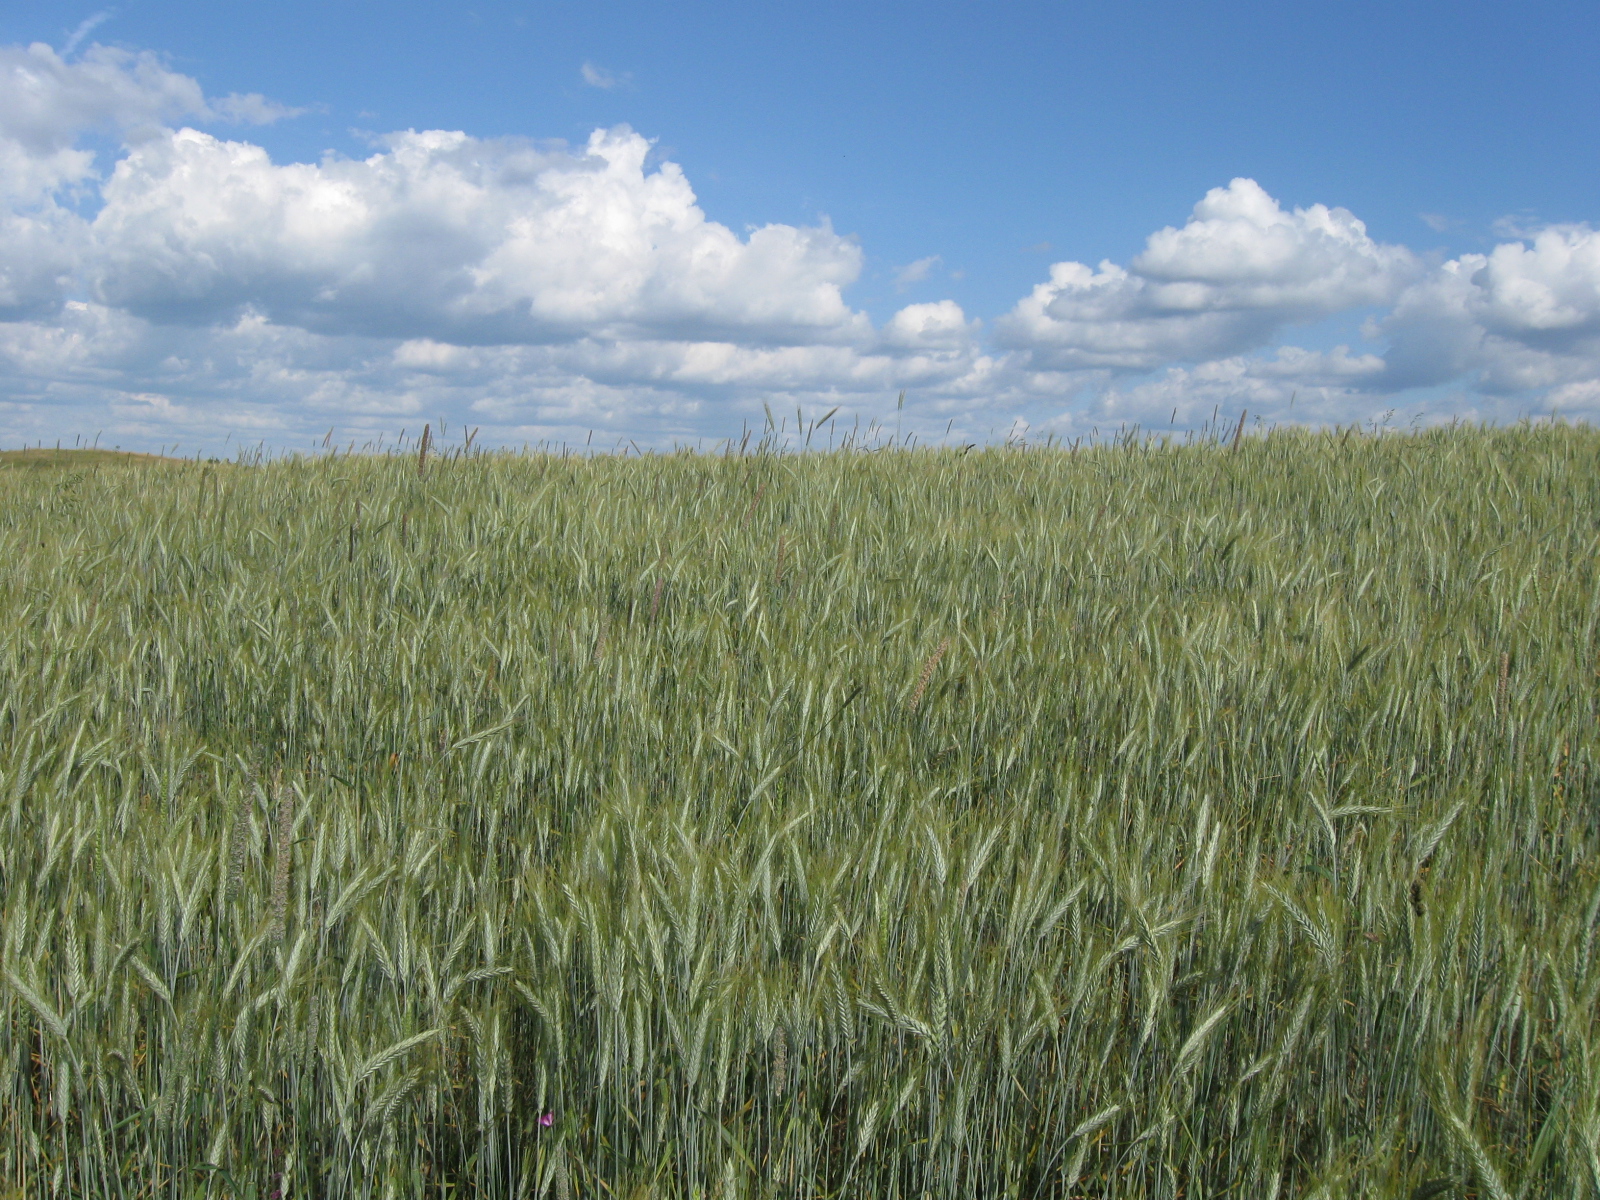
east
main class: Cropland
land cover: Triticale
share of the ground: > 75 %
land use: Agriculture (excluding fallow land and kitchen gardens)
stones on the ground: < 10 %
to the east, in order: Triticale; Grassland without tree/shrub cover
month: July
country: LT
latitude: 54.2477
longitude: 24.2949
